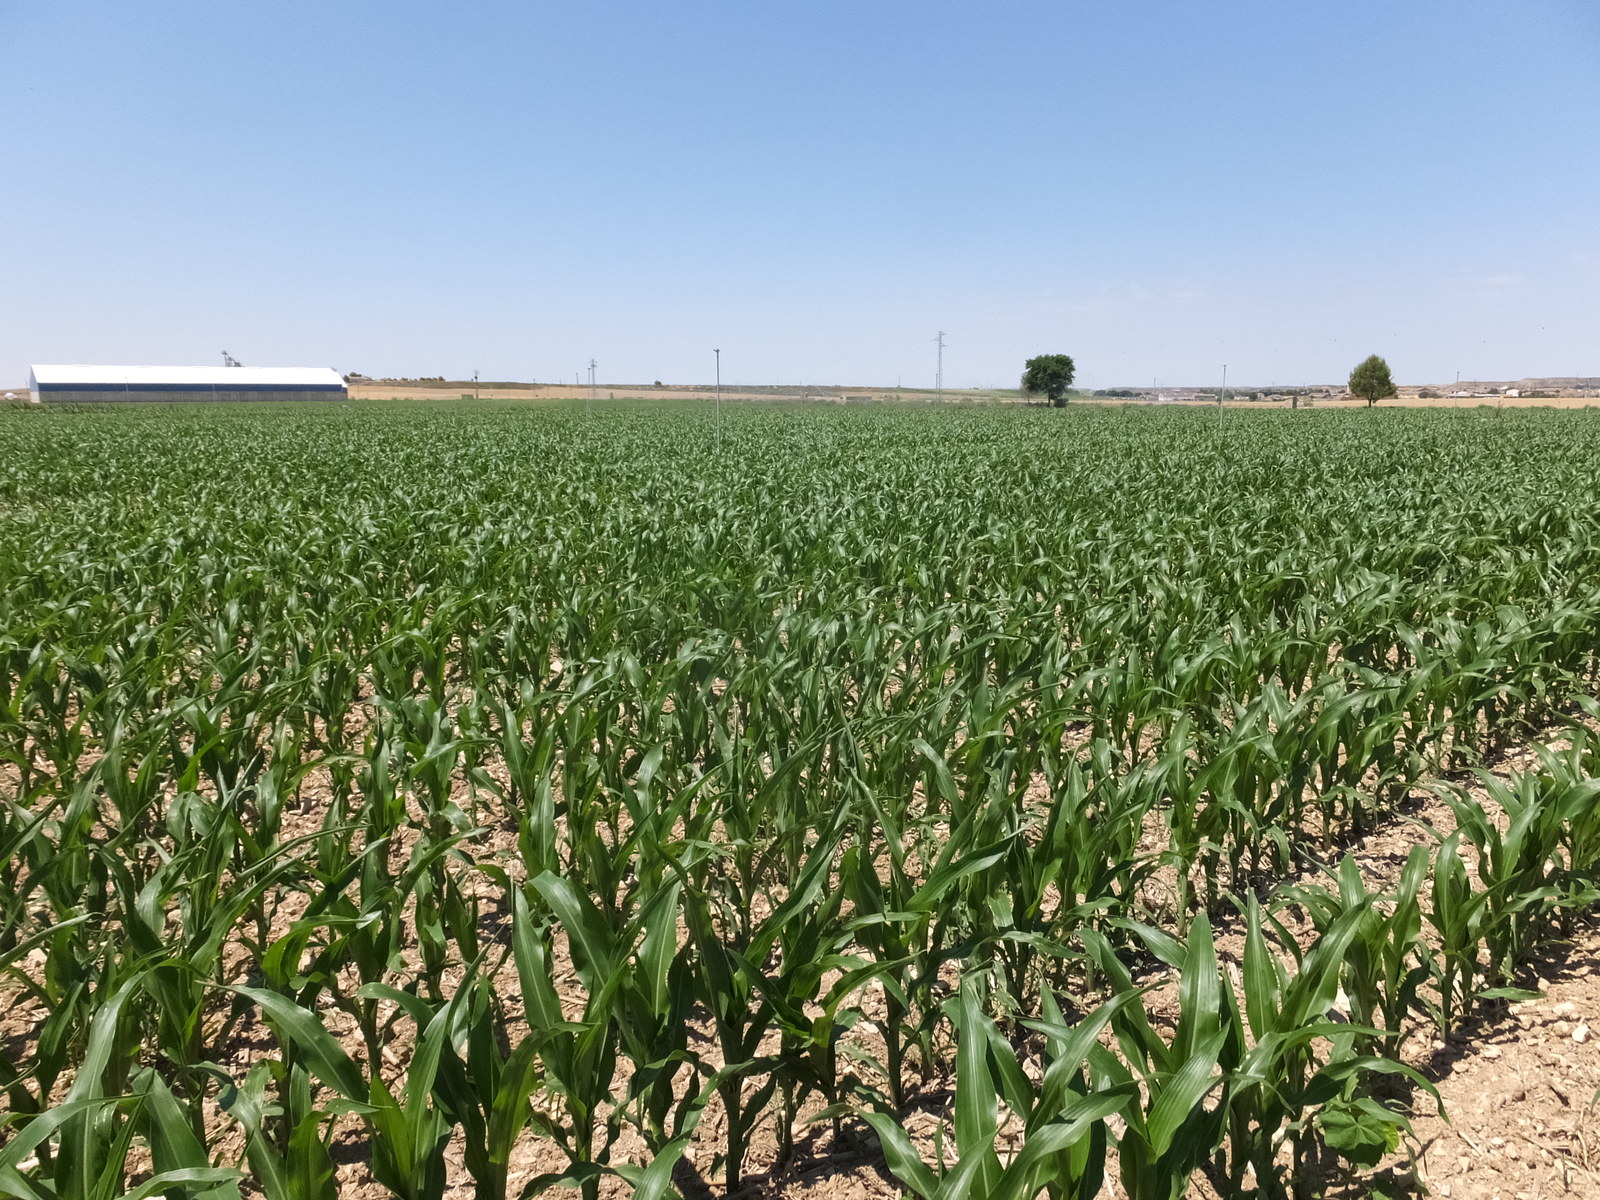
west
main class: Cropland
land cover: Maize
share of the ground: 25 - 50 %
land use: Agriculture (excluding fallow land and kitchen gardens)
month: June
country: ES
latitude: 41.4929
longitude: 0.0800
